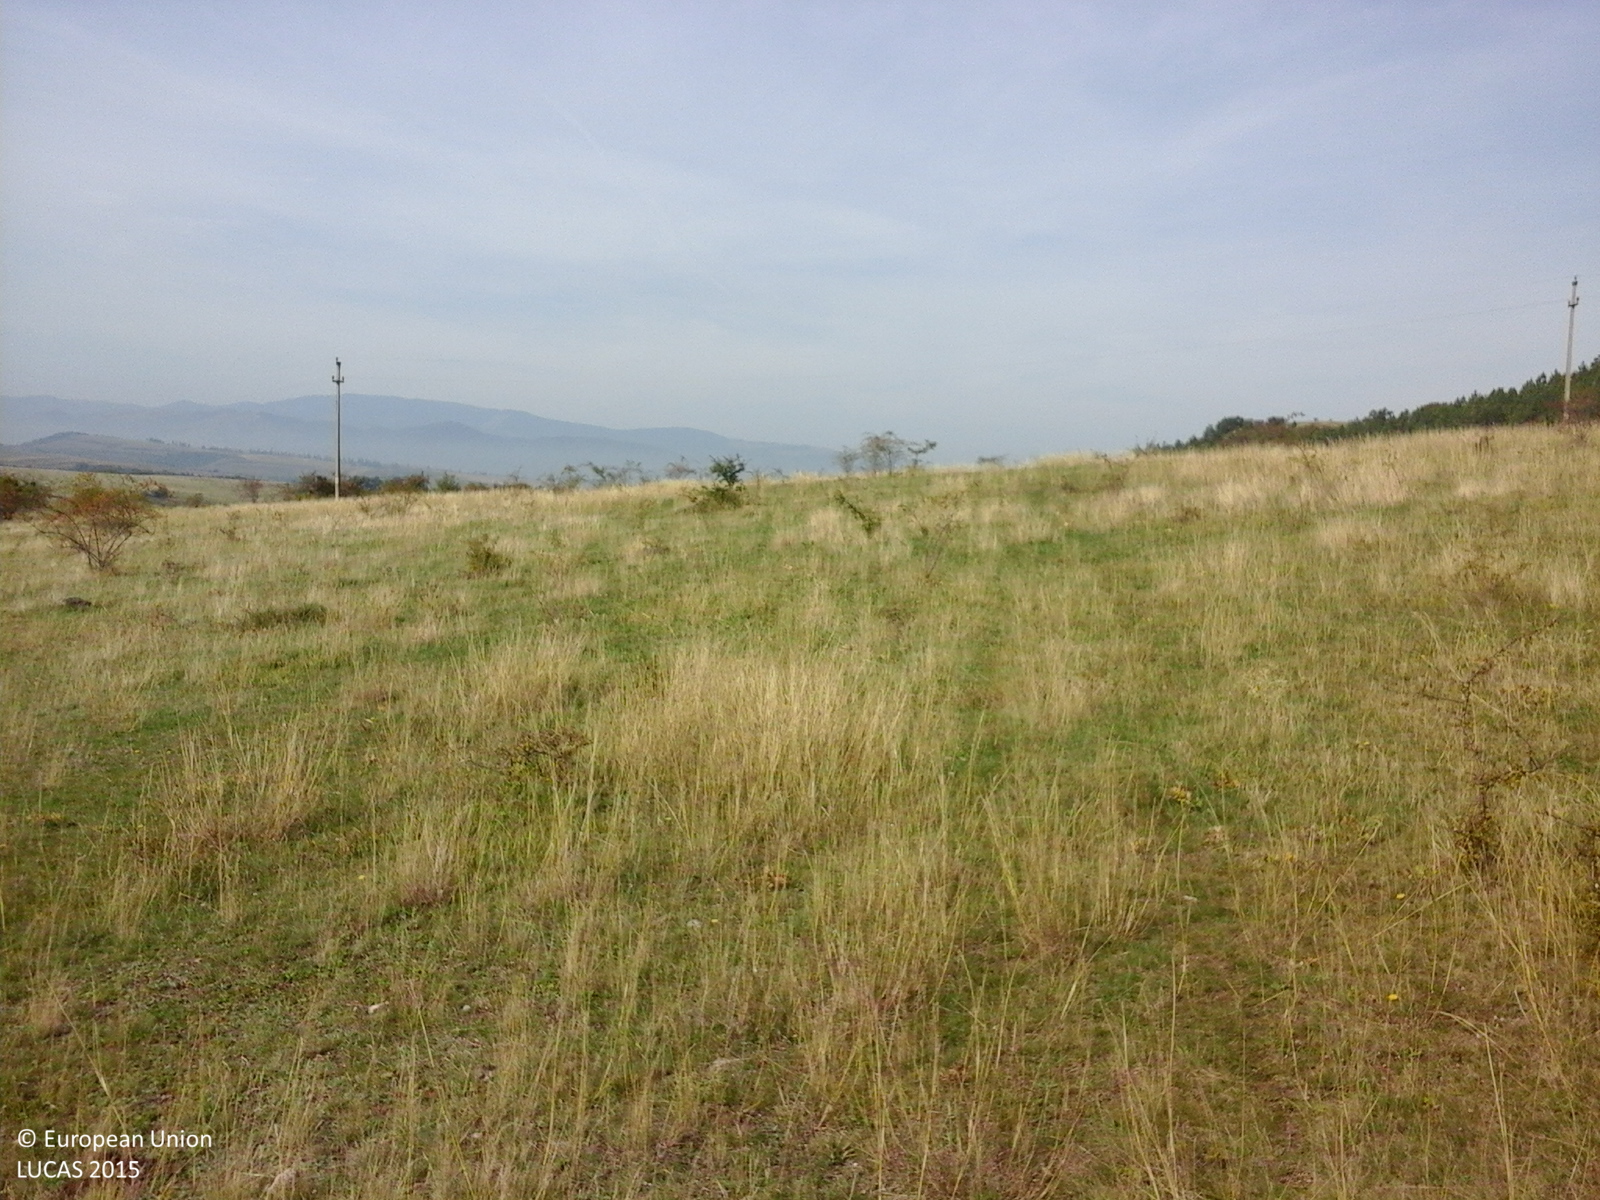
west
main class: Grassland
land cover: Spontaneously vegetated surfaces
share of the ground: > 75 %
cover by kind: herbaceous plants 100 %
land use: Fallow land
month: September
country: RO
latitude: 46.8528
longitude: 23.1129
